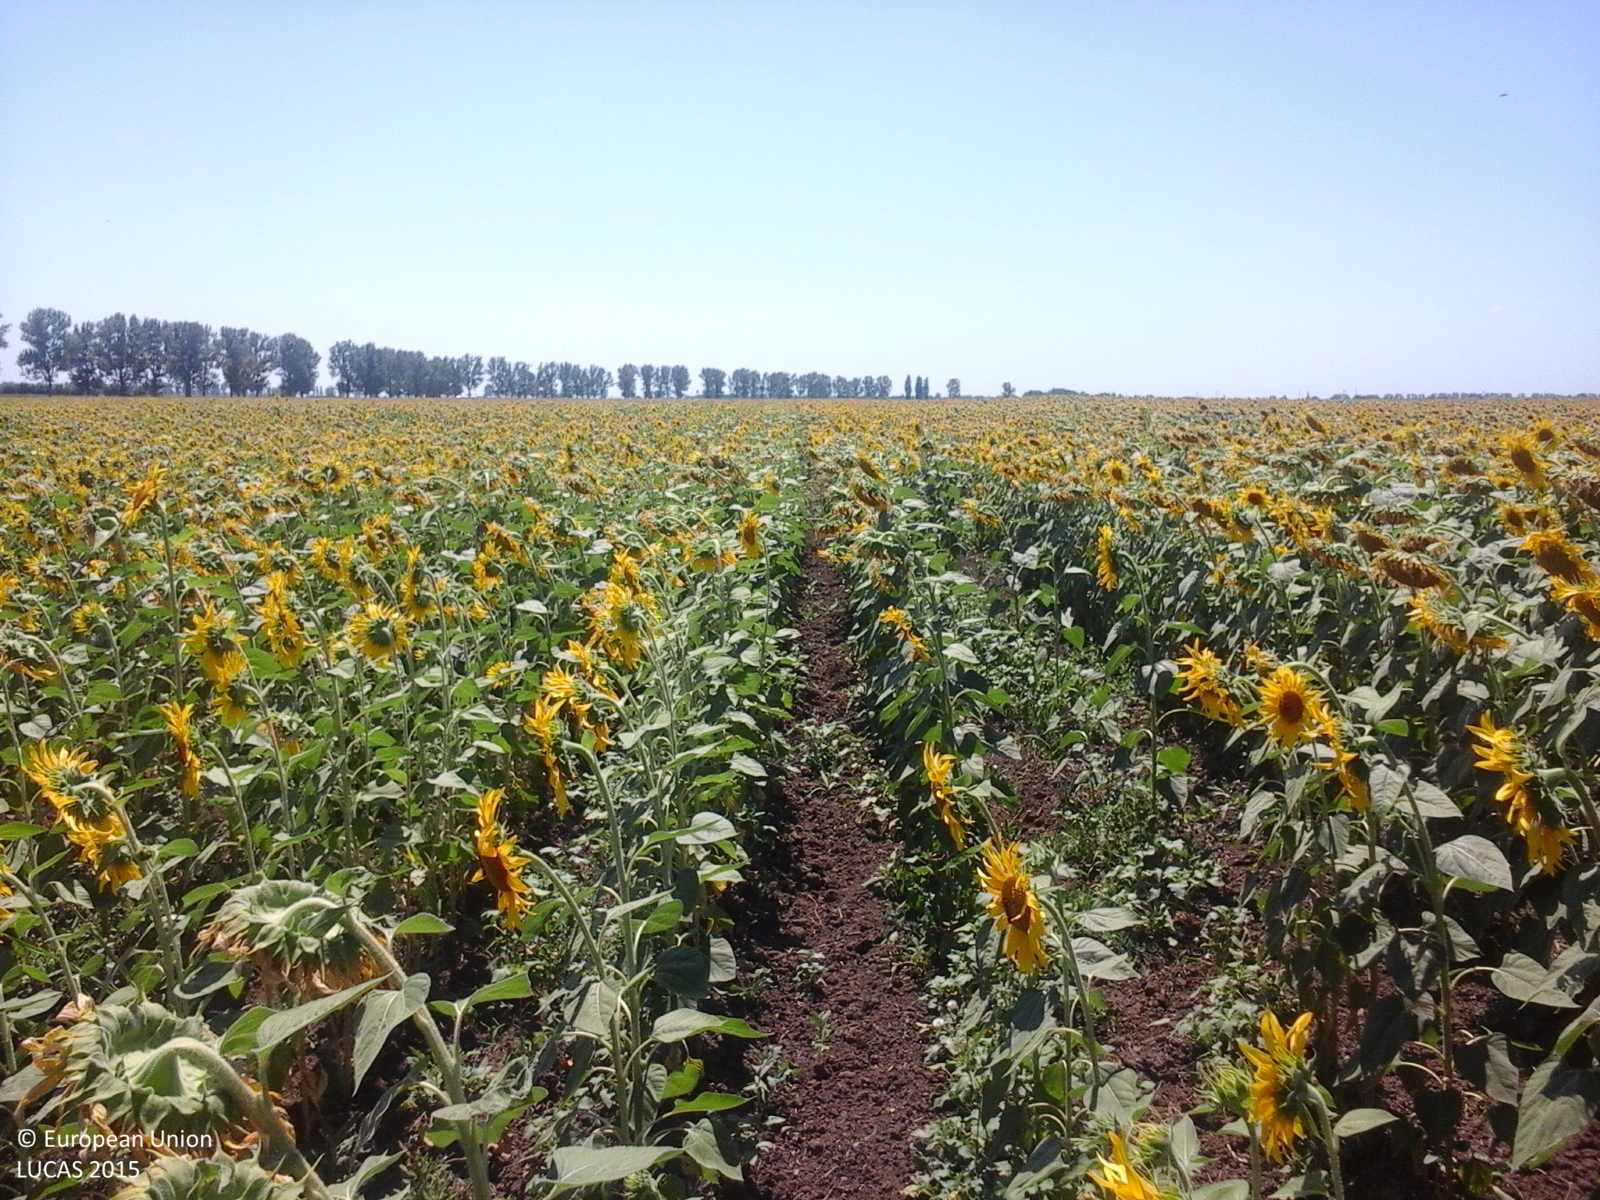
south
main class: Cropland
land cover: Sunflower
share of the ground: > 75 %
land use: Agriculture (excluding fallow land and kitchen gardens)
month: July
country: RO
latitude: 44.2546
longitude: 26.5850
